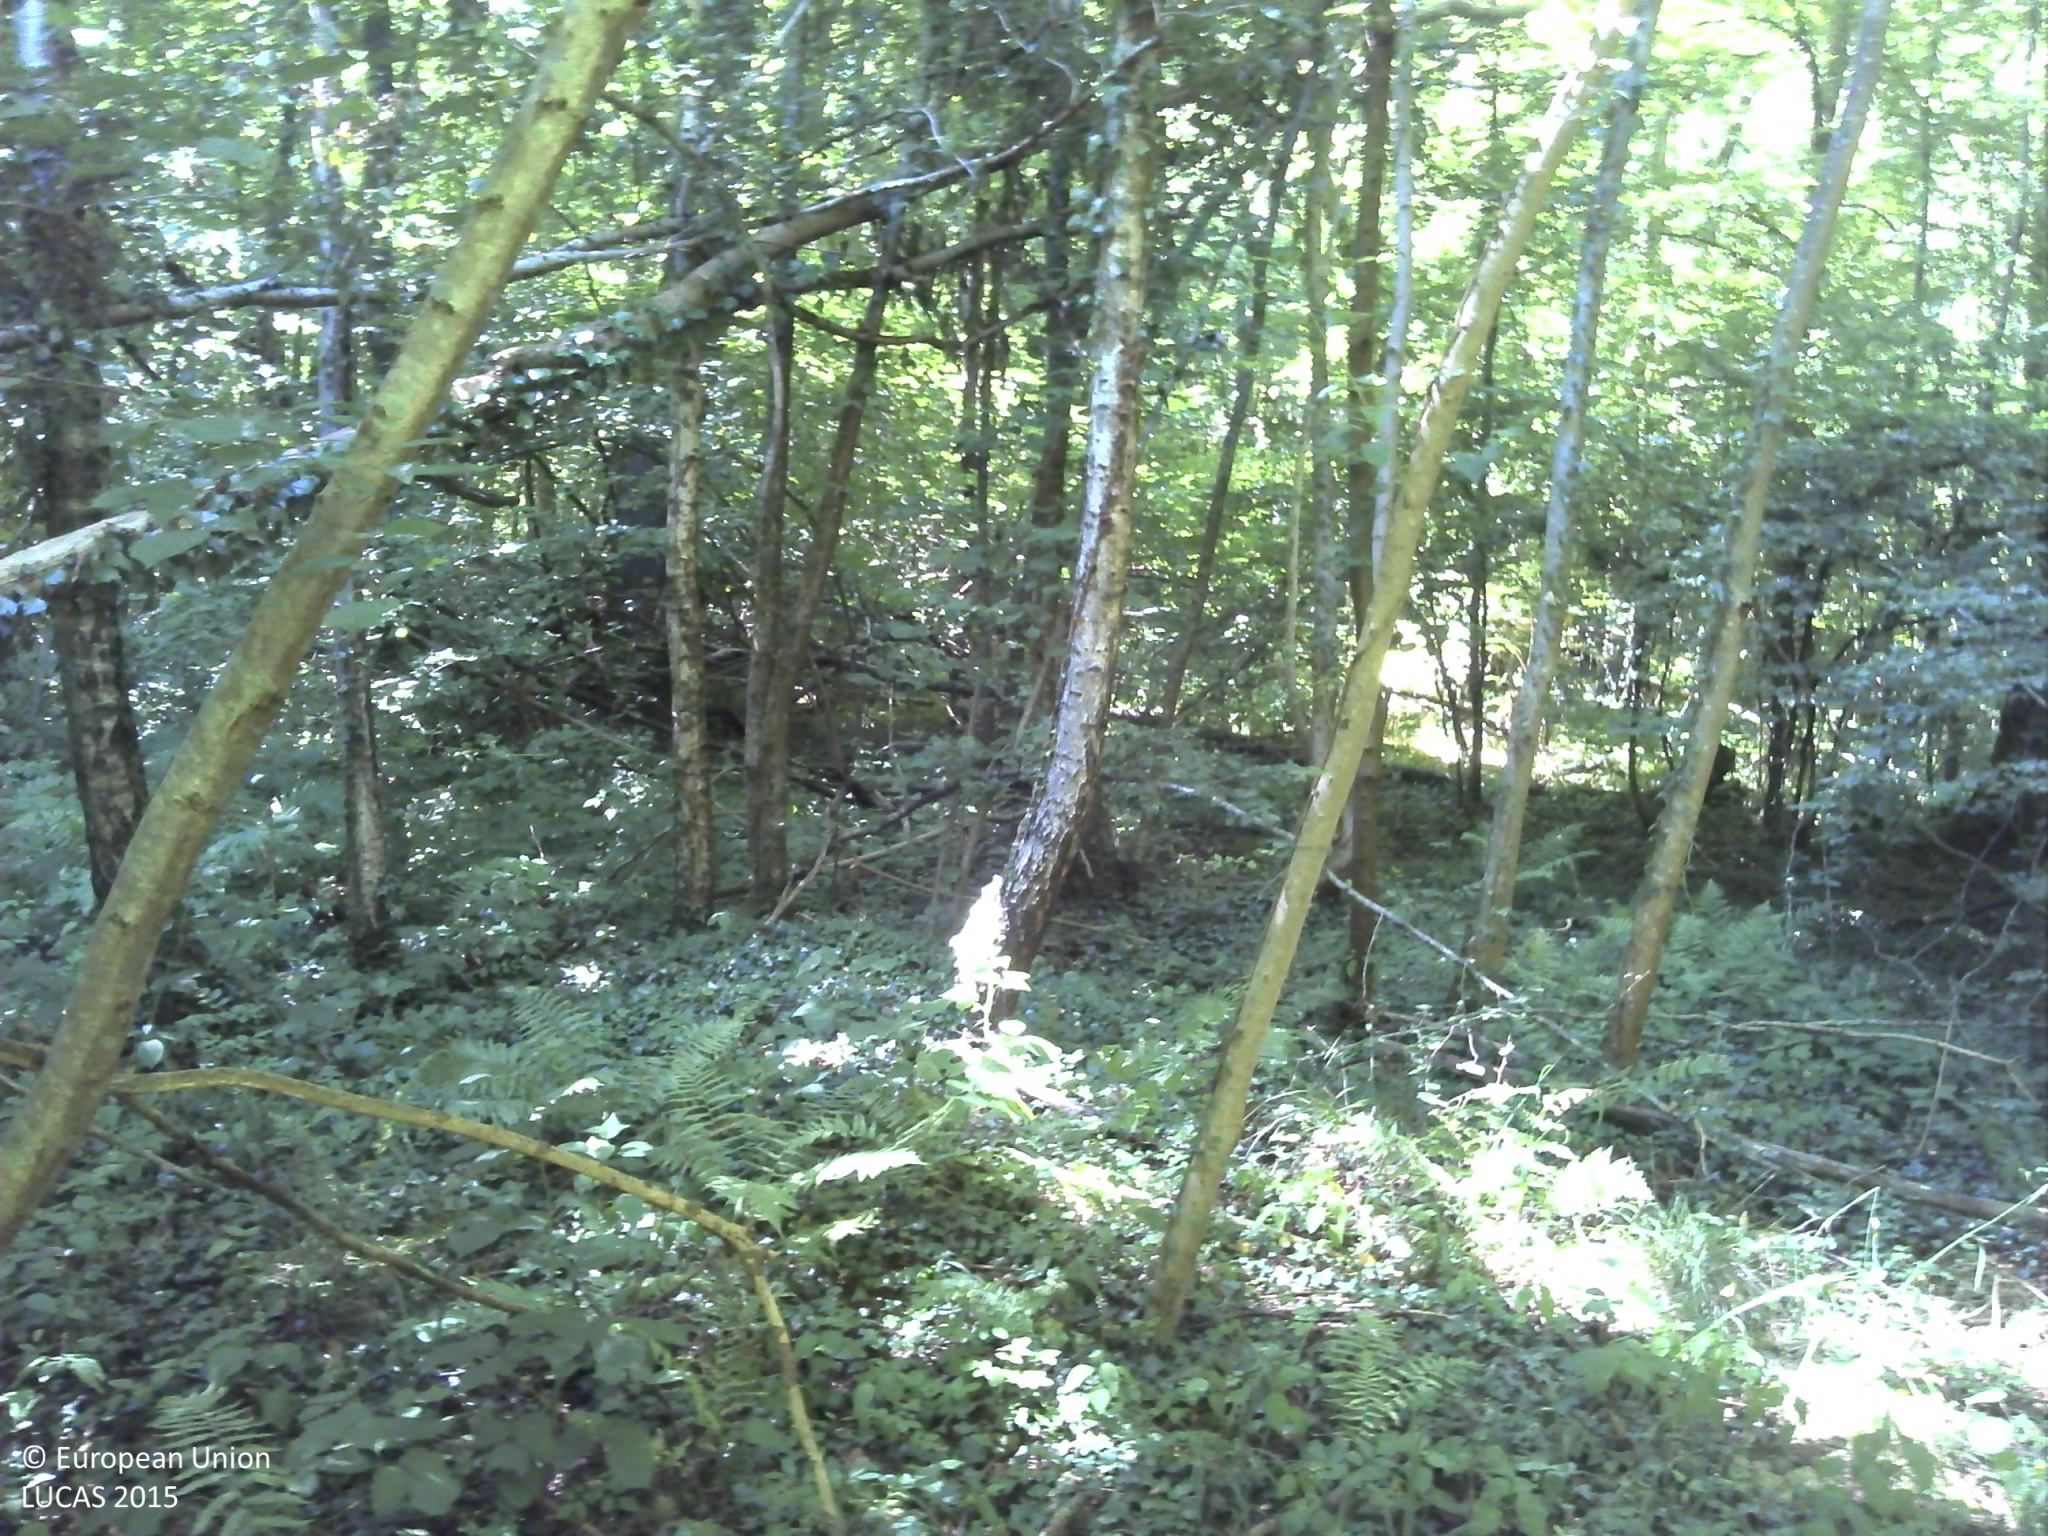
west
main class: Woodland
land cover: Broadleaved woodland
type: beech forest
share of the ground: > 75 %
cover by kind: broadleaved forest trees 60 %, herbaceous plants 30 %, lichens and mosses 5 %, consolidated bare surface 5 %
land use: Forestry
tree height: > 5 m
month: July
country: FR
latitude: 49.5386
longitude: 4.7042
